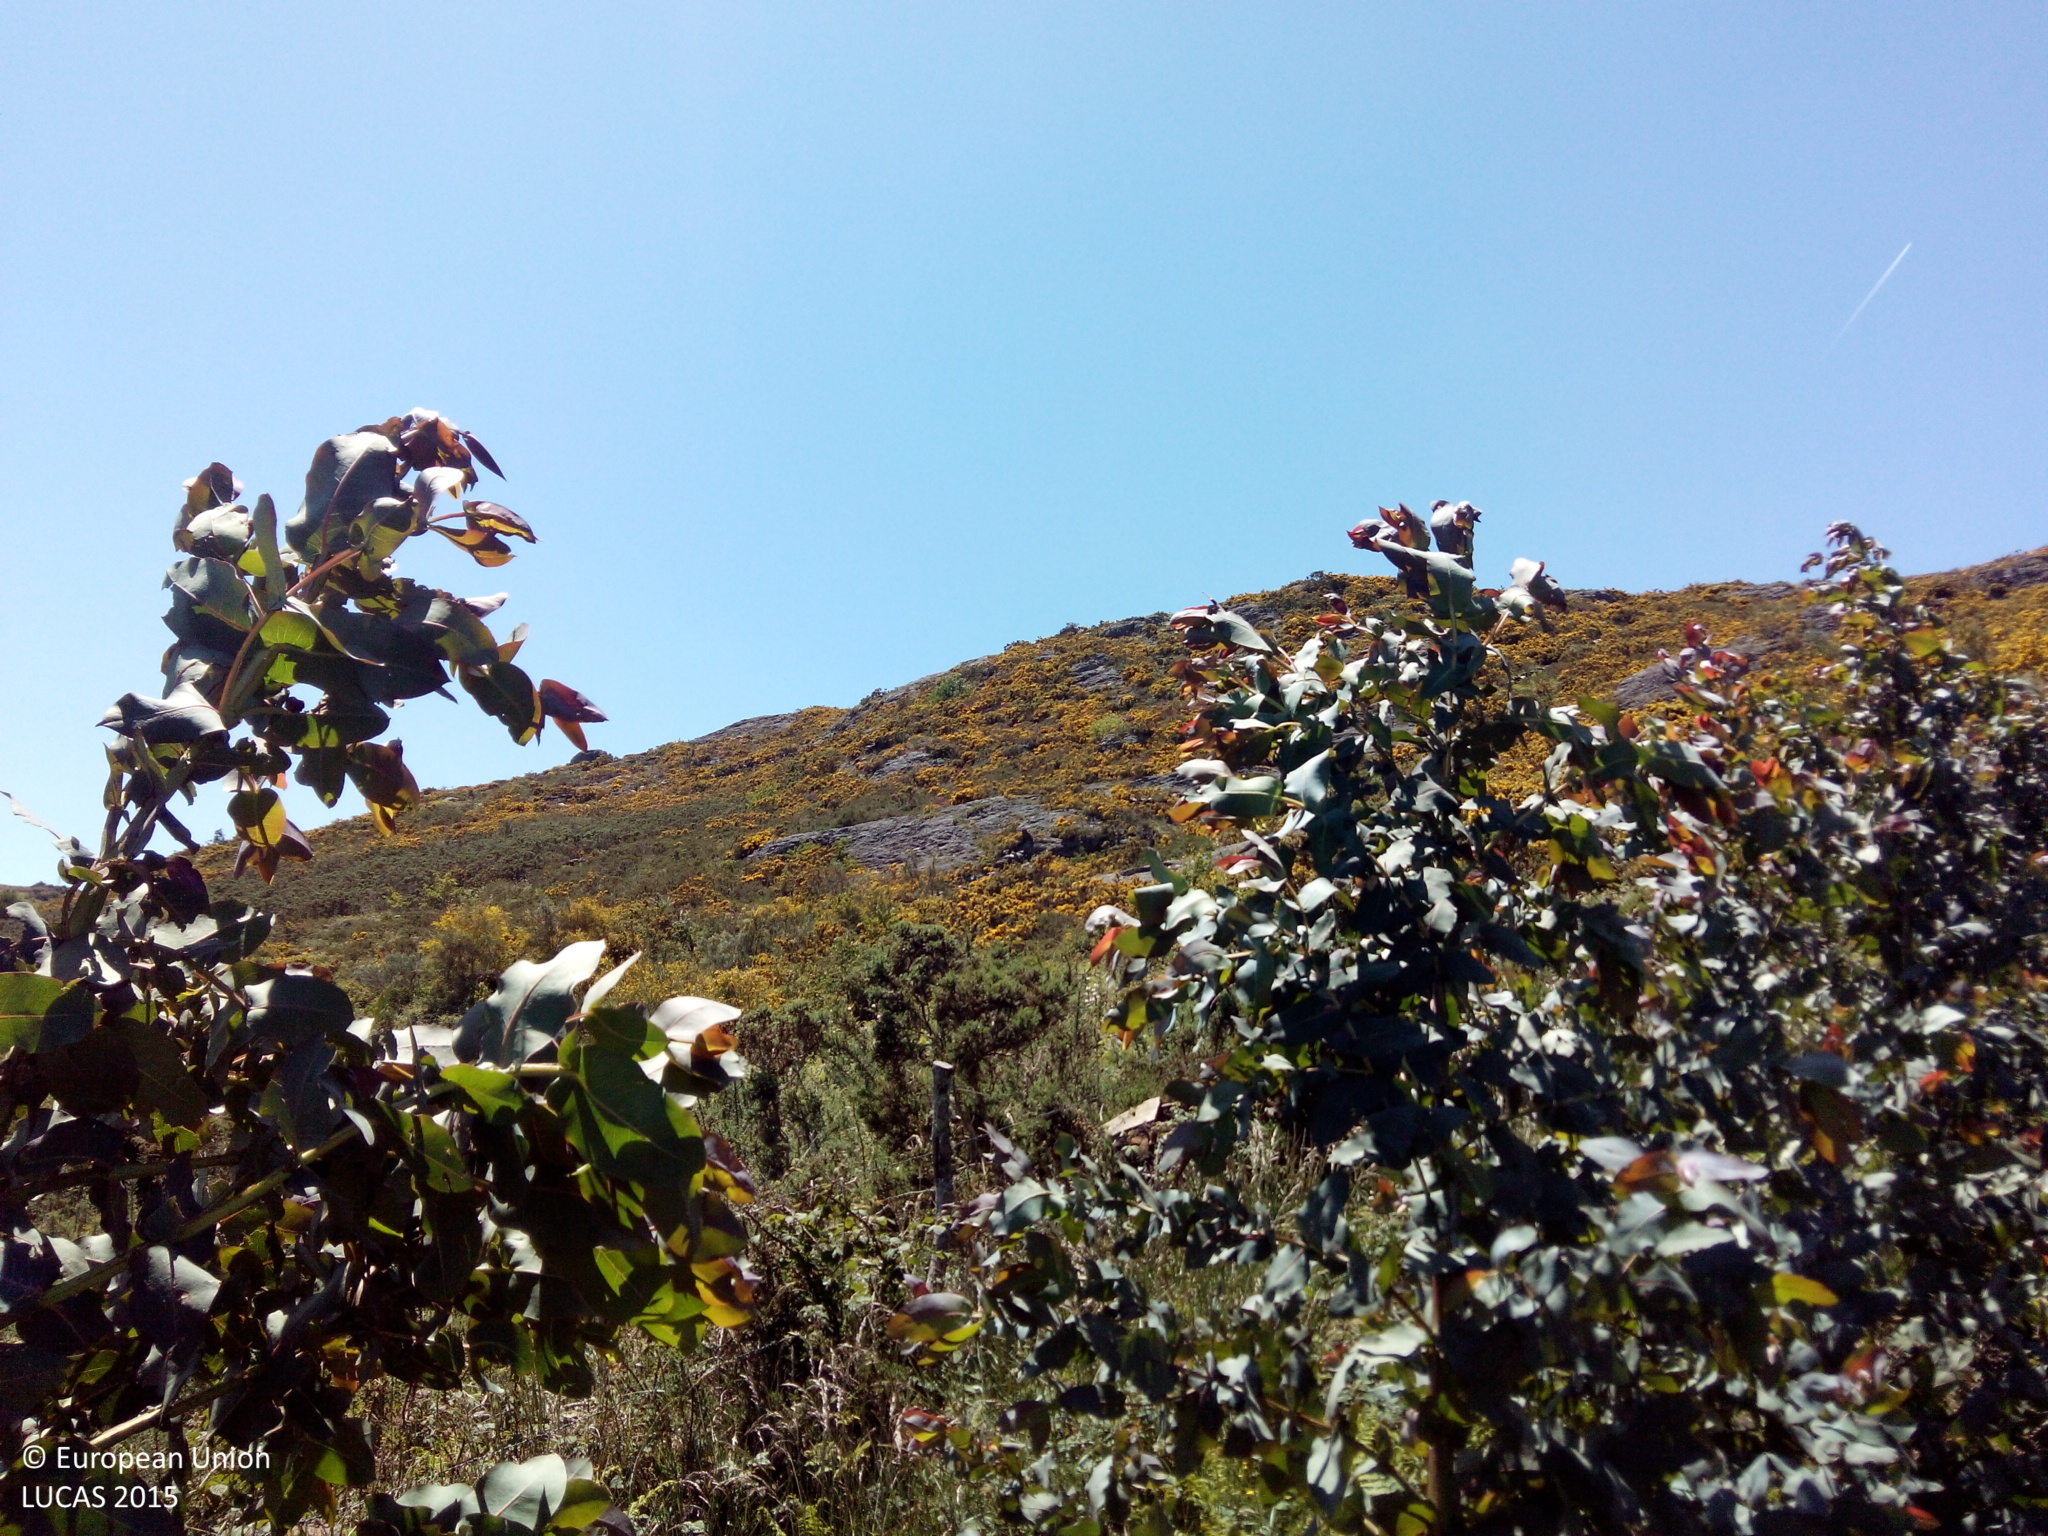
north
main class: Woodland
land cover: Broadleaved woodland
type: exotic forest
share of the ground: > 75 %
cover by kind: broadleaved forest trees 75 %, herbaceous plants 15 %, shrubs 10 %
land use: Forestry
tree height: < 5 m
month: May
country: ES
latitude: 42.6146
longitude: -8.3949
